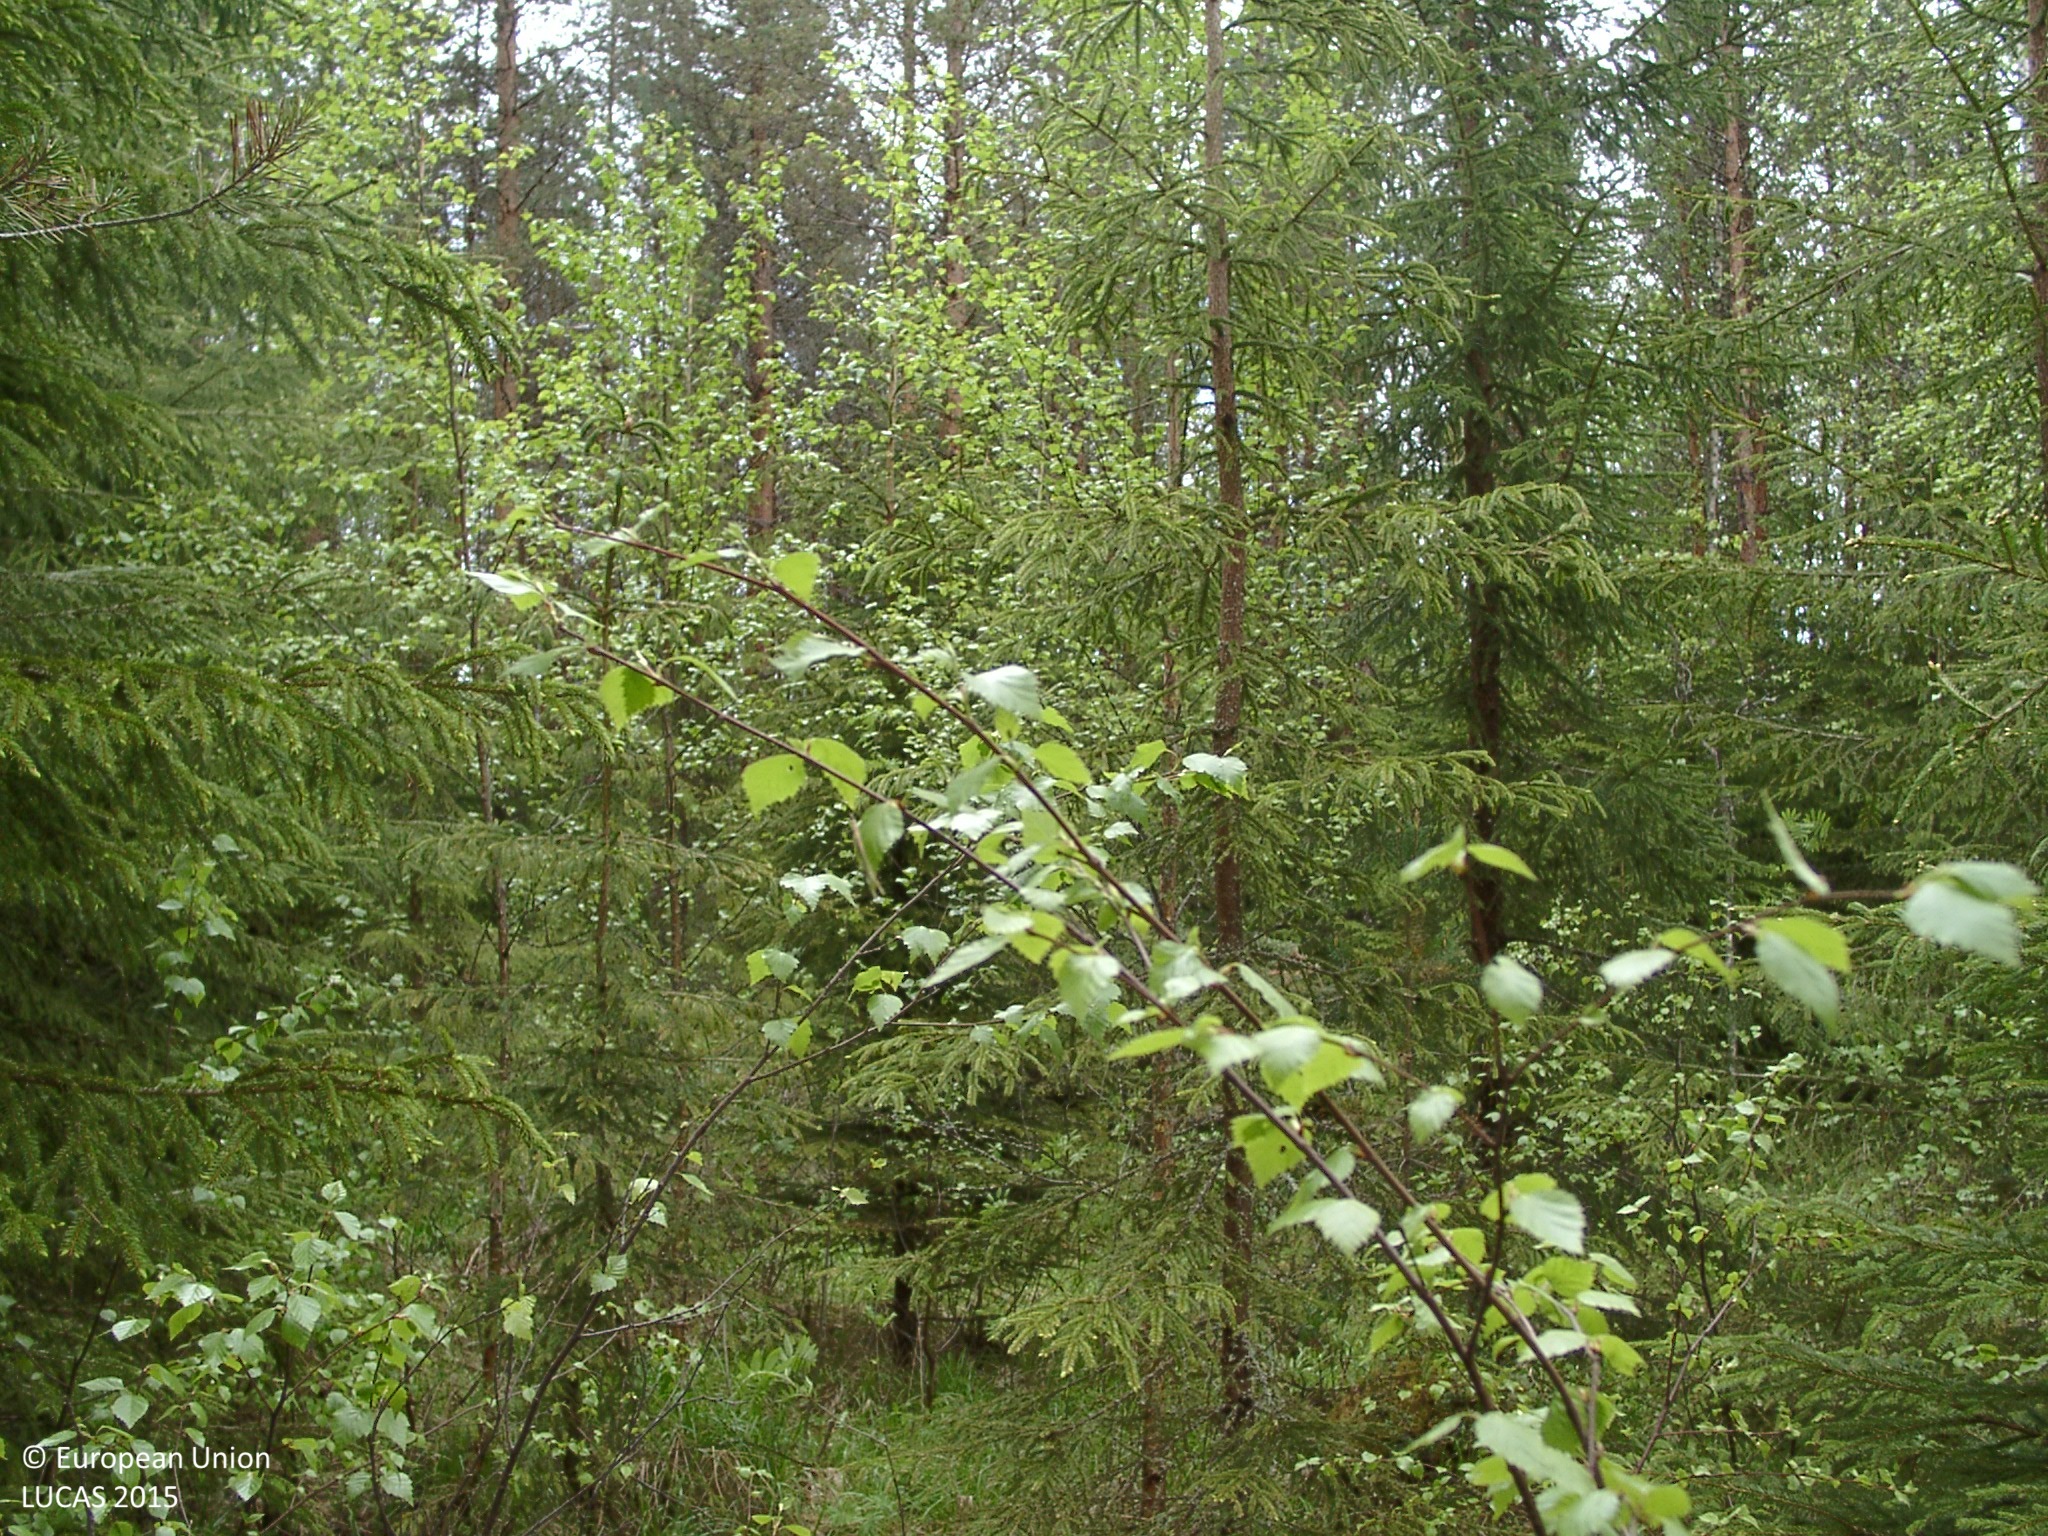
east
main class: Woodland
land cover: Spruce dominated mixed woodland
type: boreal forest
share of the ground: 50 - 75 %
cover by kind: coniferous forest trees 45 %, herbaceous plants 25 %, broadleaved forest trees 20 %, shrubs 5 %, lichens and mosses 5 %
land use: Forestry
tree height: > 5 m
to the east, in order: Spruce dominated mixed woodland; Pine dominated coniferous woodland; Pine dominated mixed woodland
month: June
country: FI
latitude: 62.2163
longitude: 25.5972
